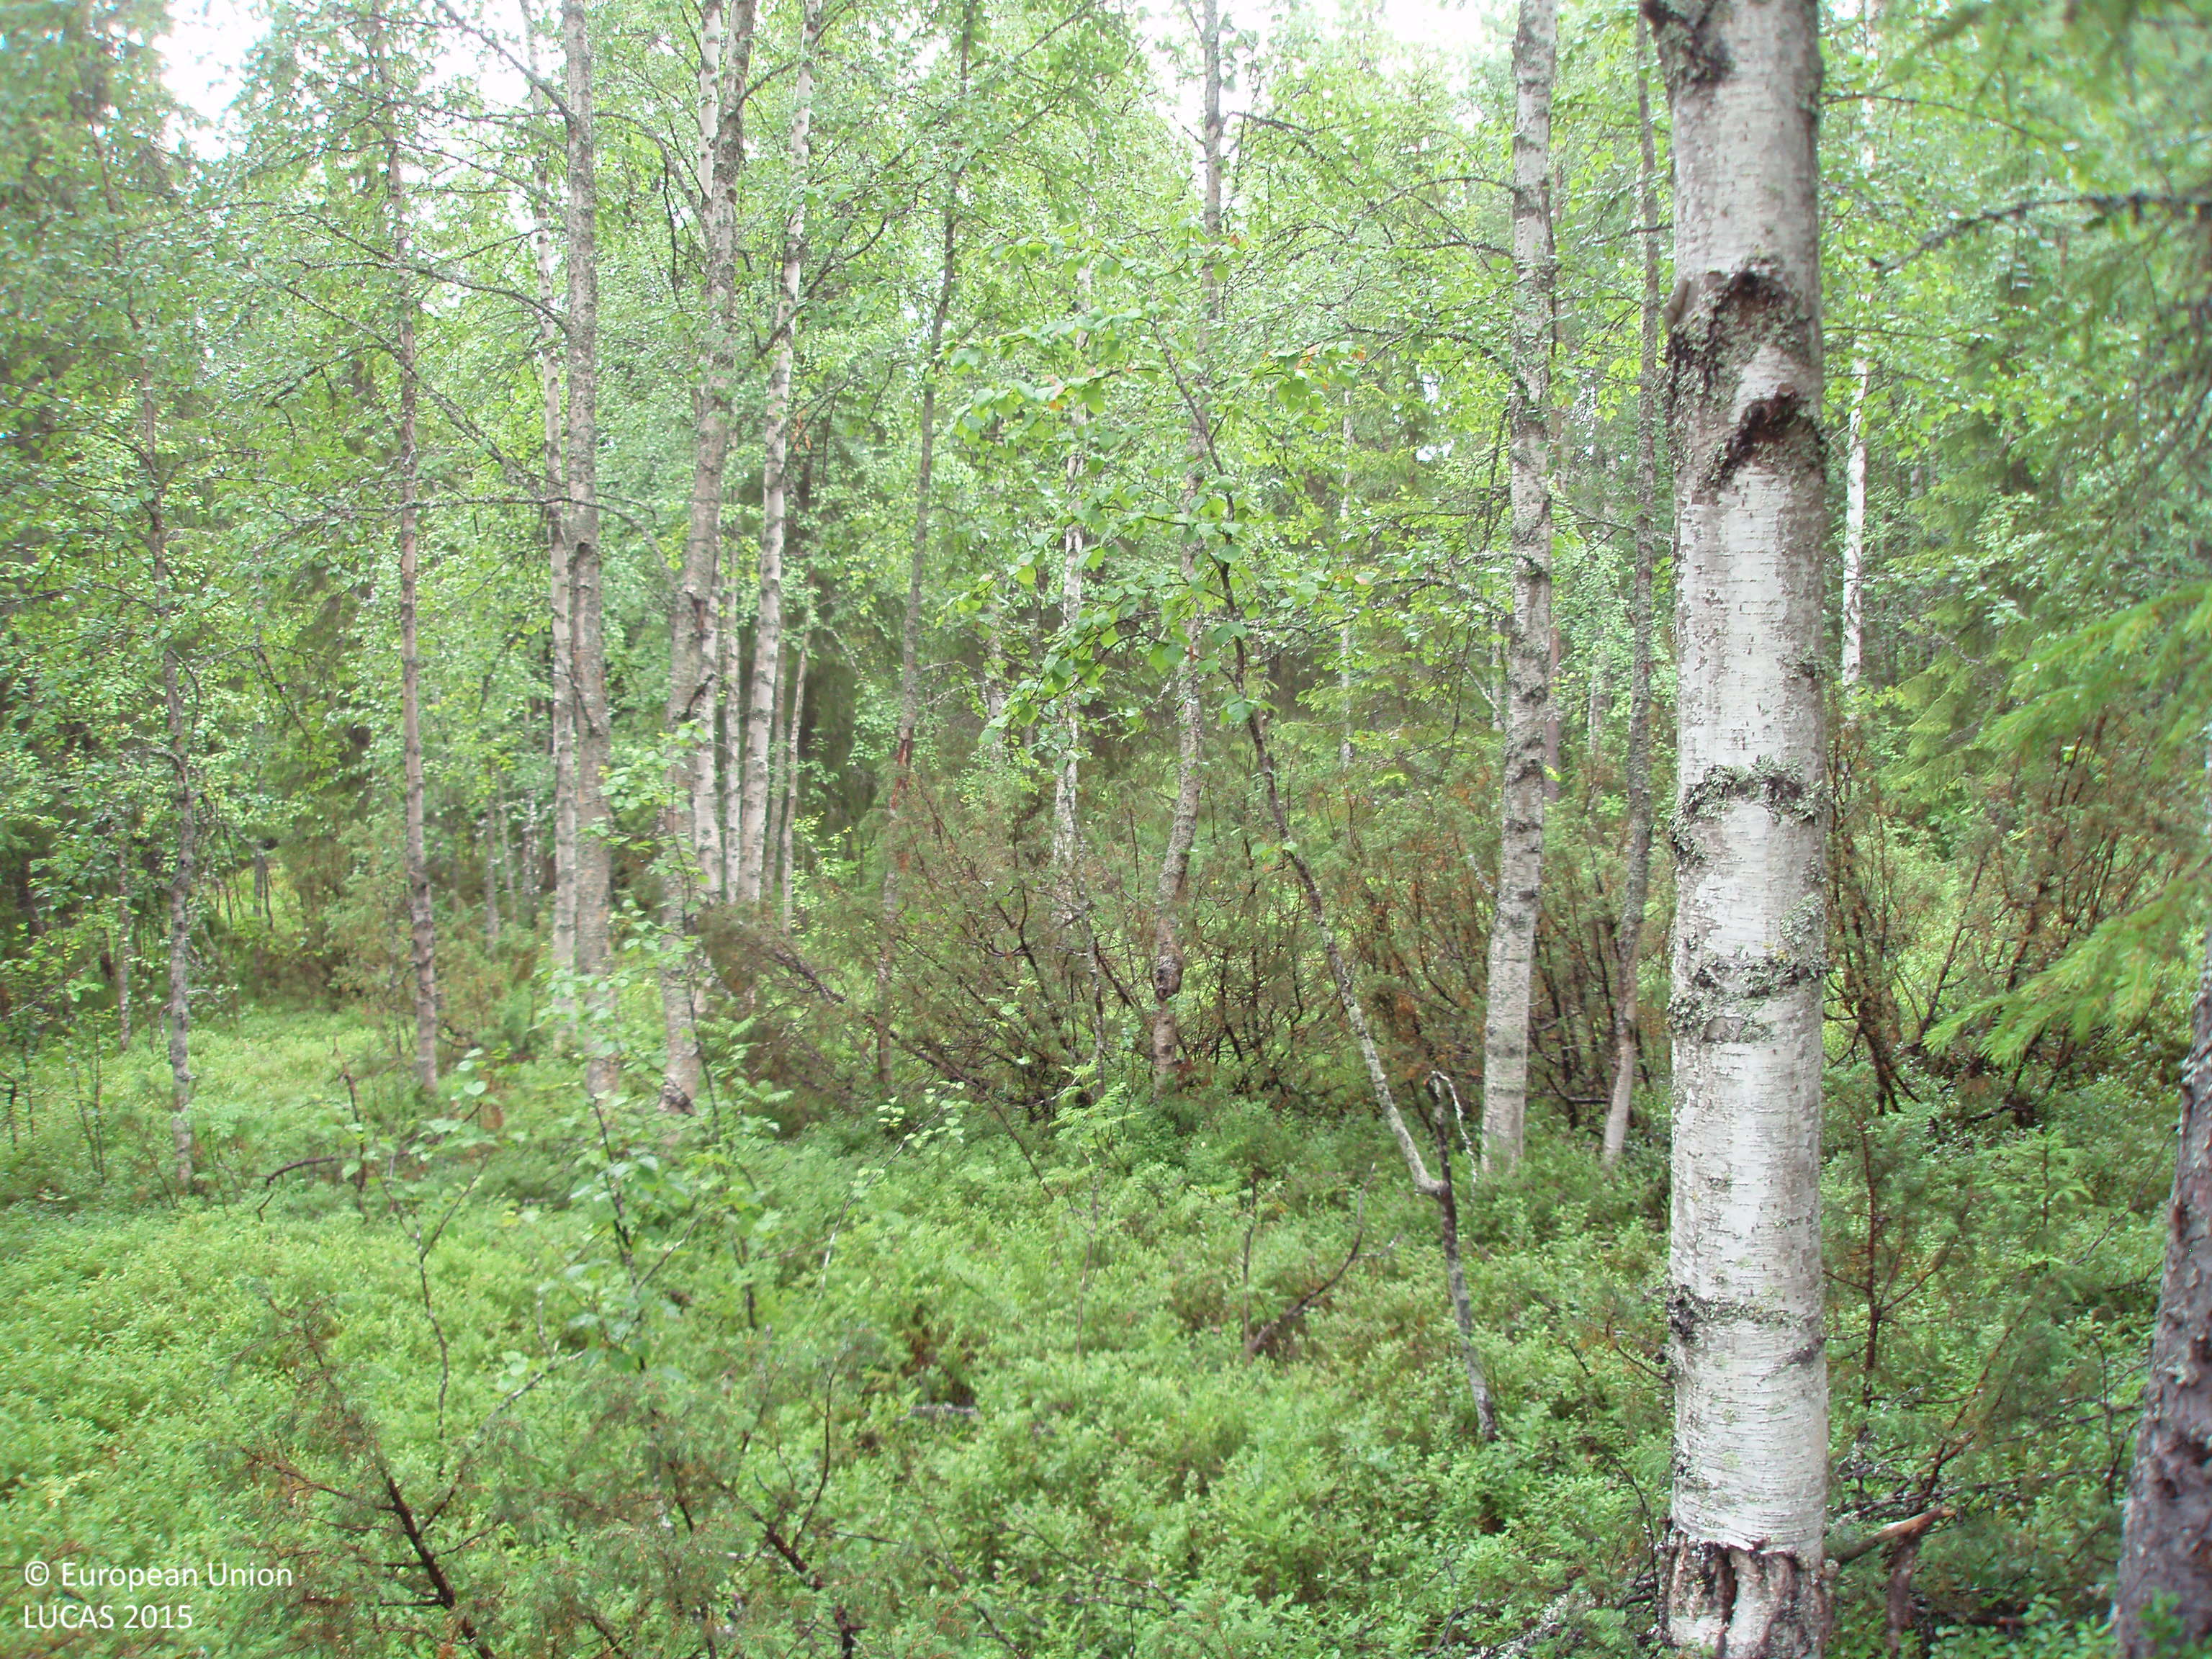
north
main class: Woodland
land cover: Spruce dominated mixed woodland
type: boreal forest
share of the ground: > 75 %
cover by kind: coniferous forest trees 40 %, broadleaved forest trees 35 %, shrubs 25 %
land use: Forestry
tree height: > 5 m
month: August
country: FI
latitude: 65.6310
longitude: 27.6603
